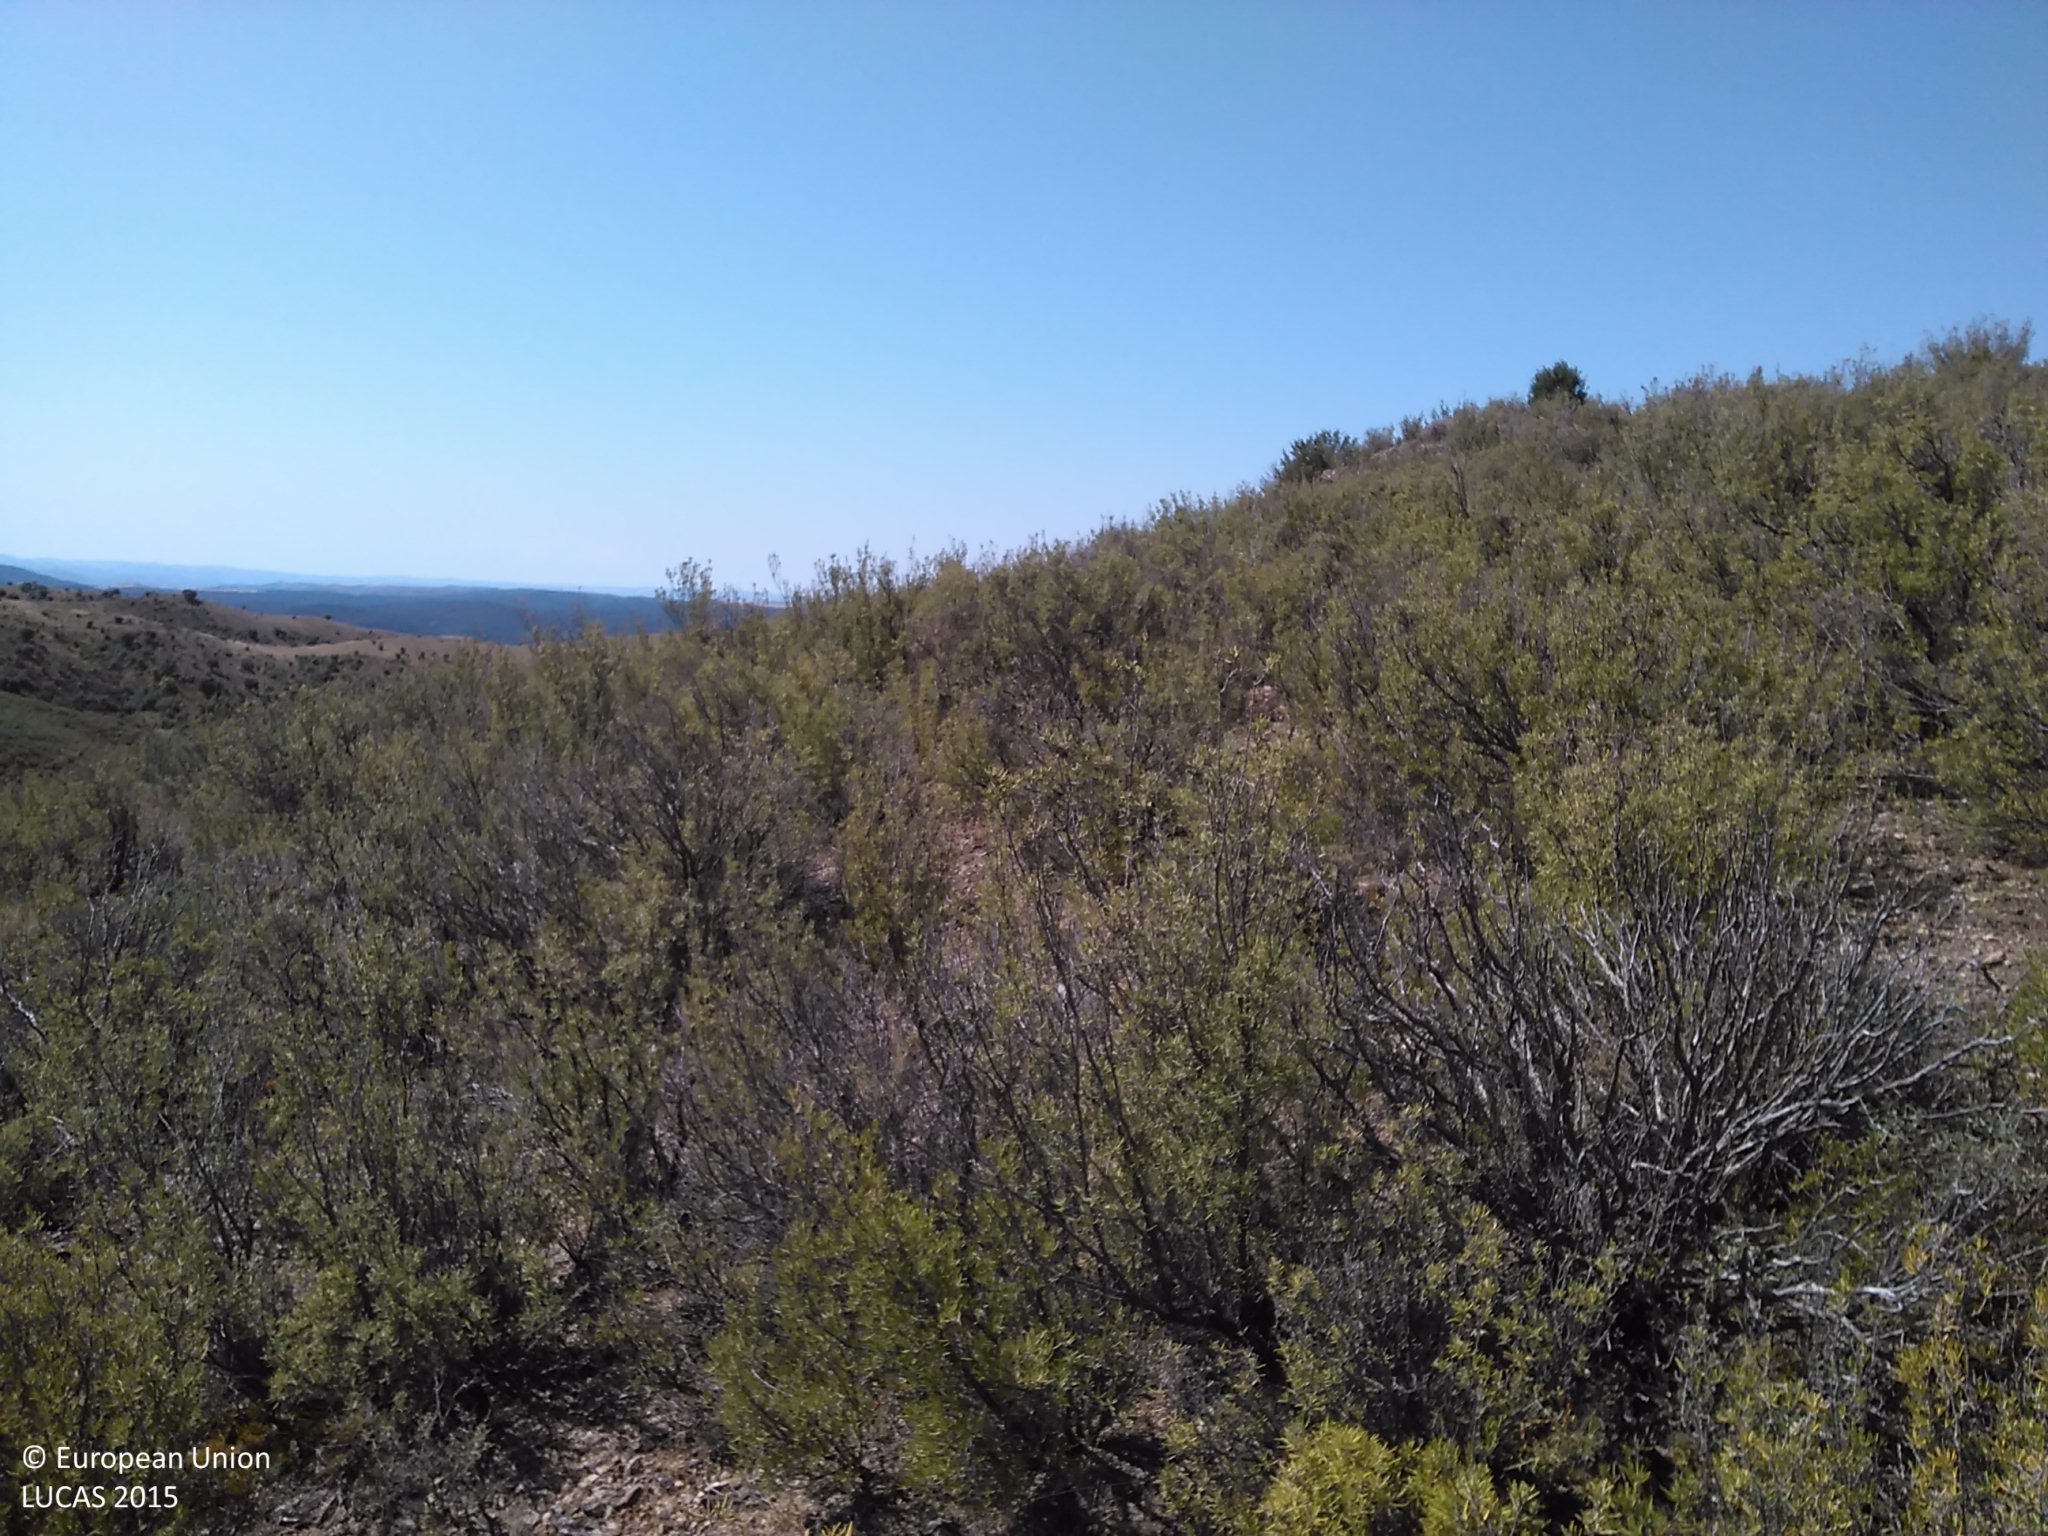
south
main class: Shrubland
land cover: Shrubland without tree cover
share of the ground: 50 - 75 %
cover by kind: shrubs 70 %, unconsolidated bare surface 25 %, herbaceous plants 5 %
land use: Semi-natural and natural areas not in use
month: July
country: ES
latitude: 41.4910
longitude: -1.9233
